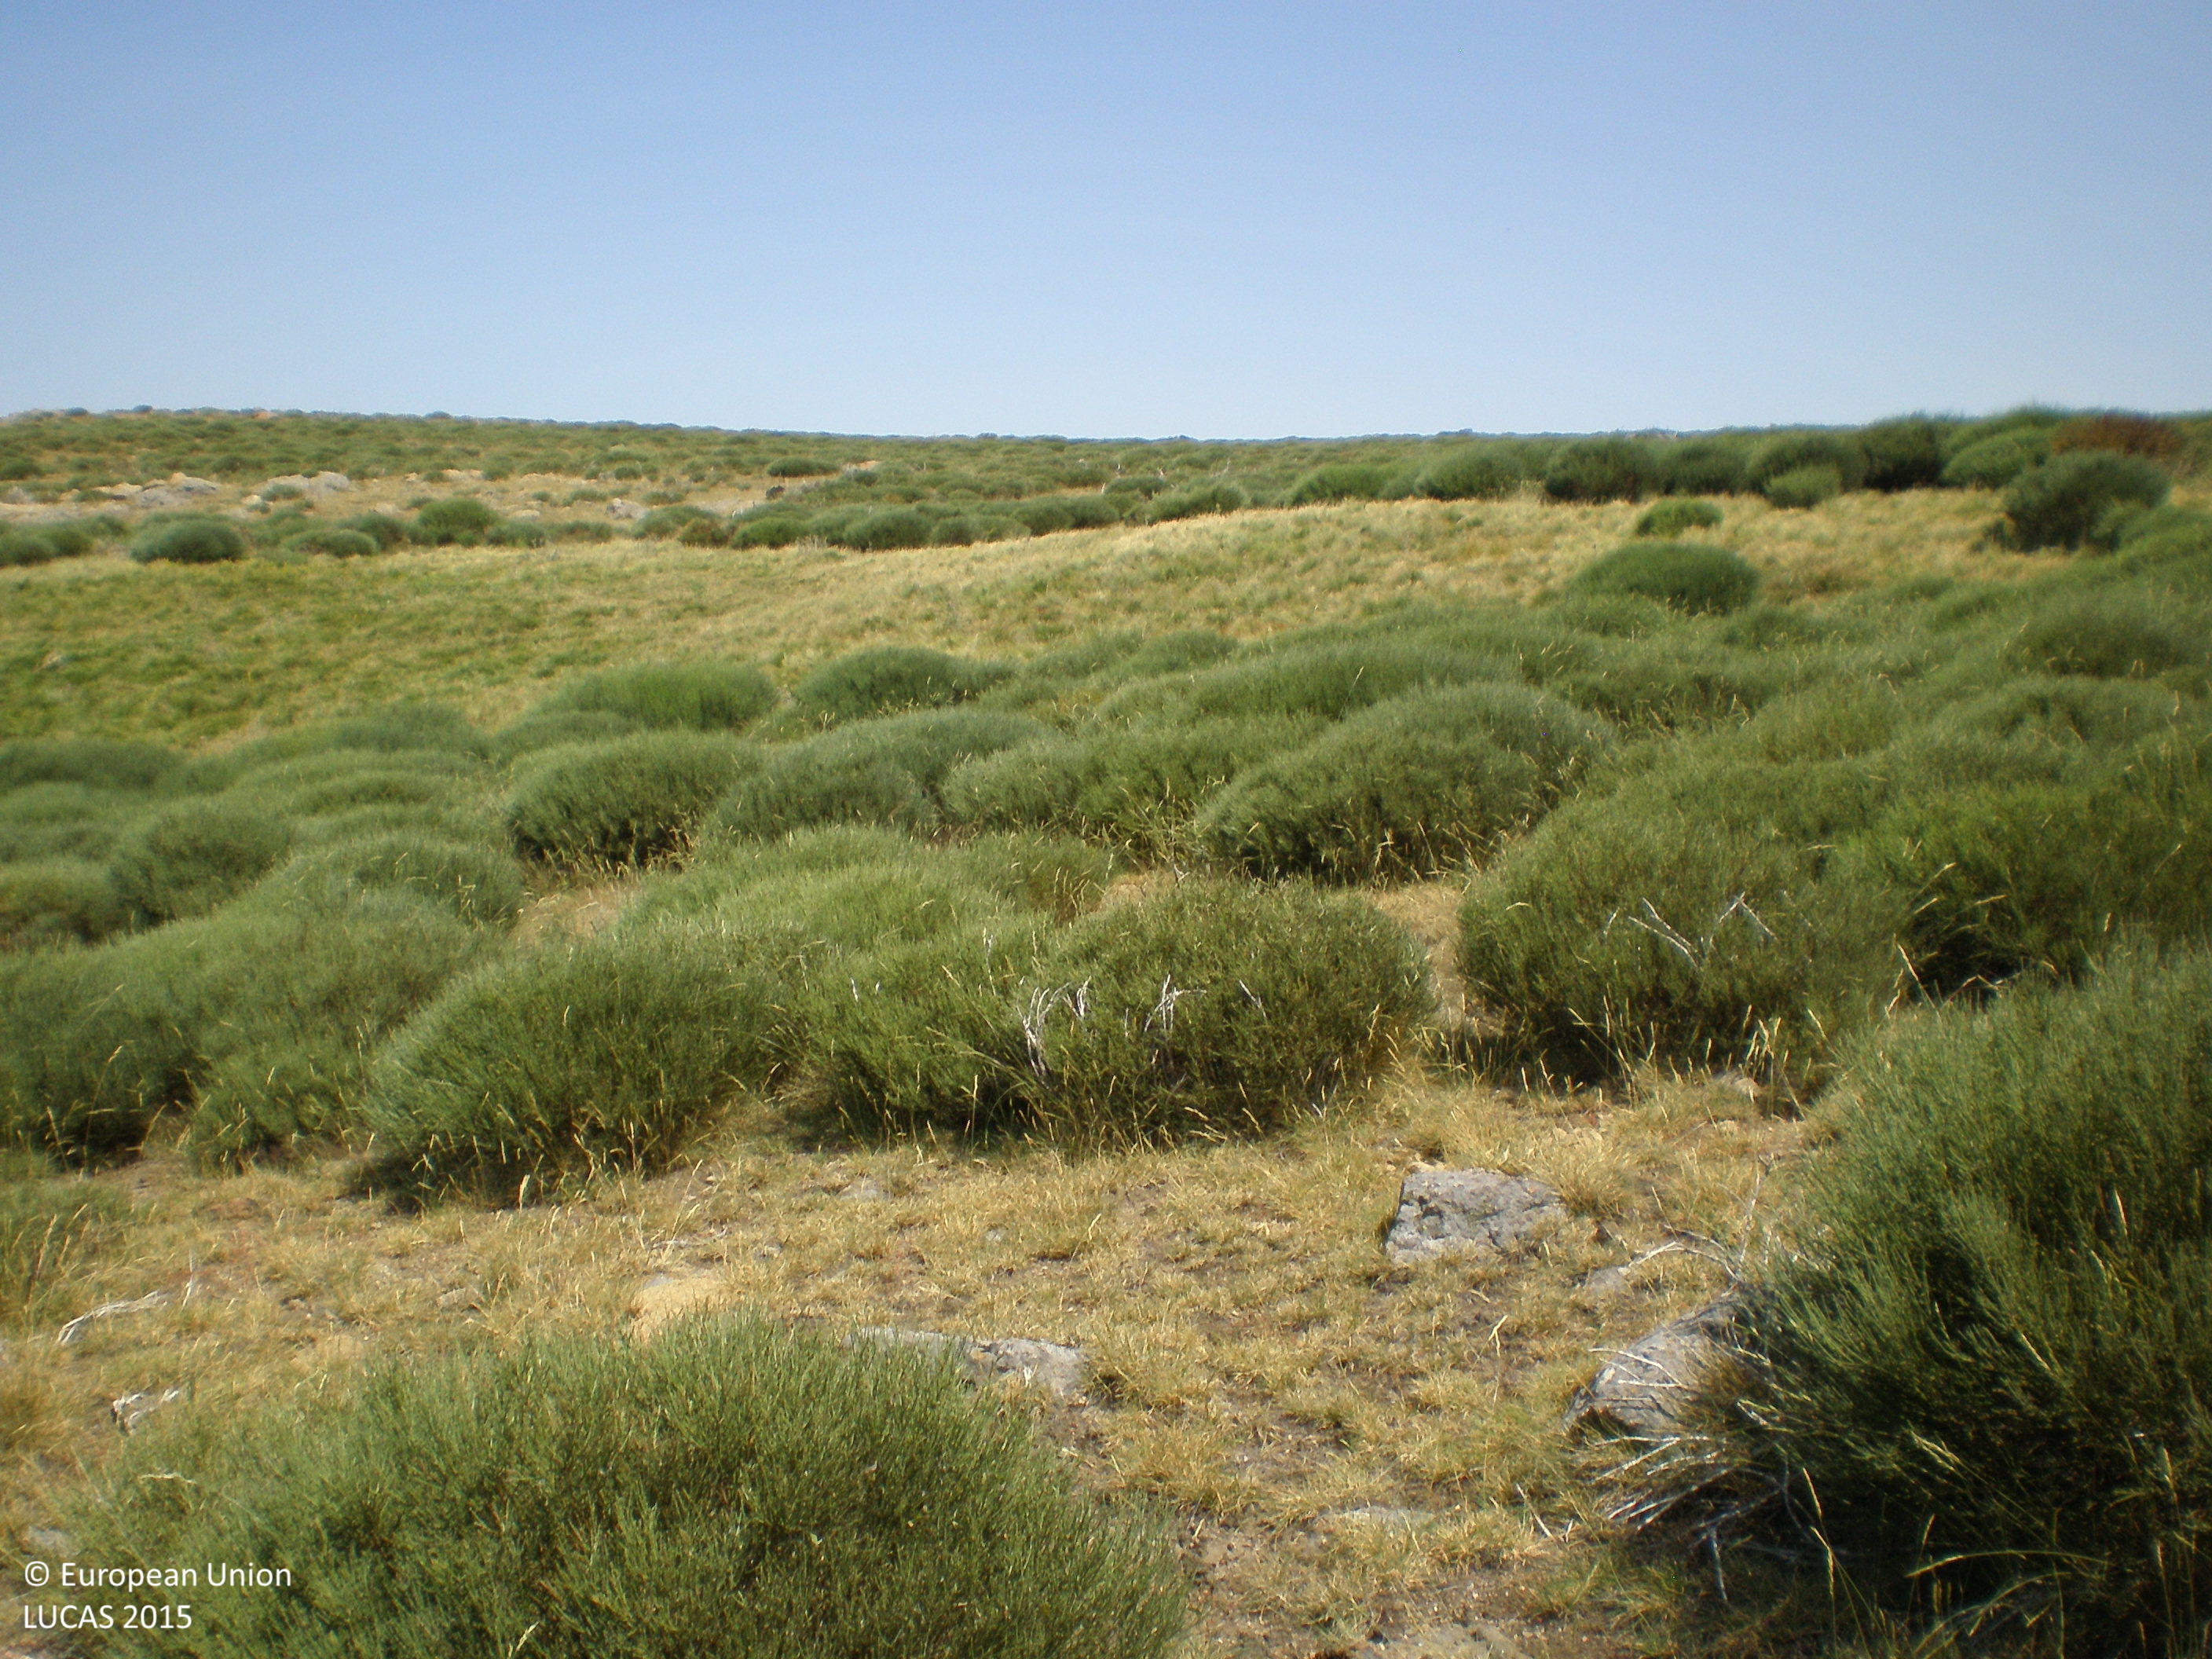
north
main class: Shrubland
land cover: Shrubland without tree cover
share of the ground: > 75 %
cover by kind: shrubs 80 %, herbaceous plants 20 %
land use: Agriculture (excluding fallow land and kitchen gardens)
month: July
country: ES
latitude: 40.4296
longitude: -5.2319
